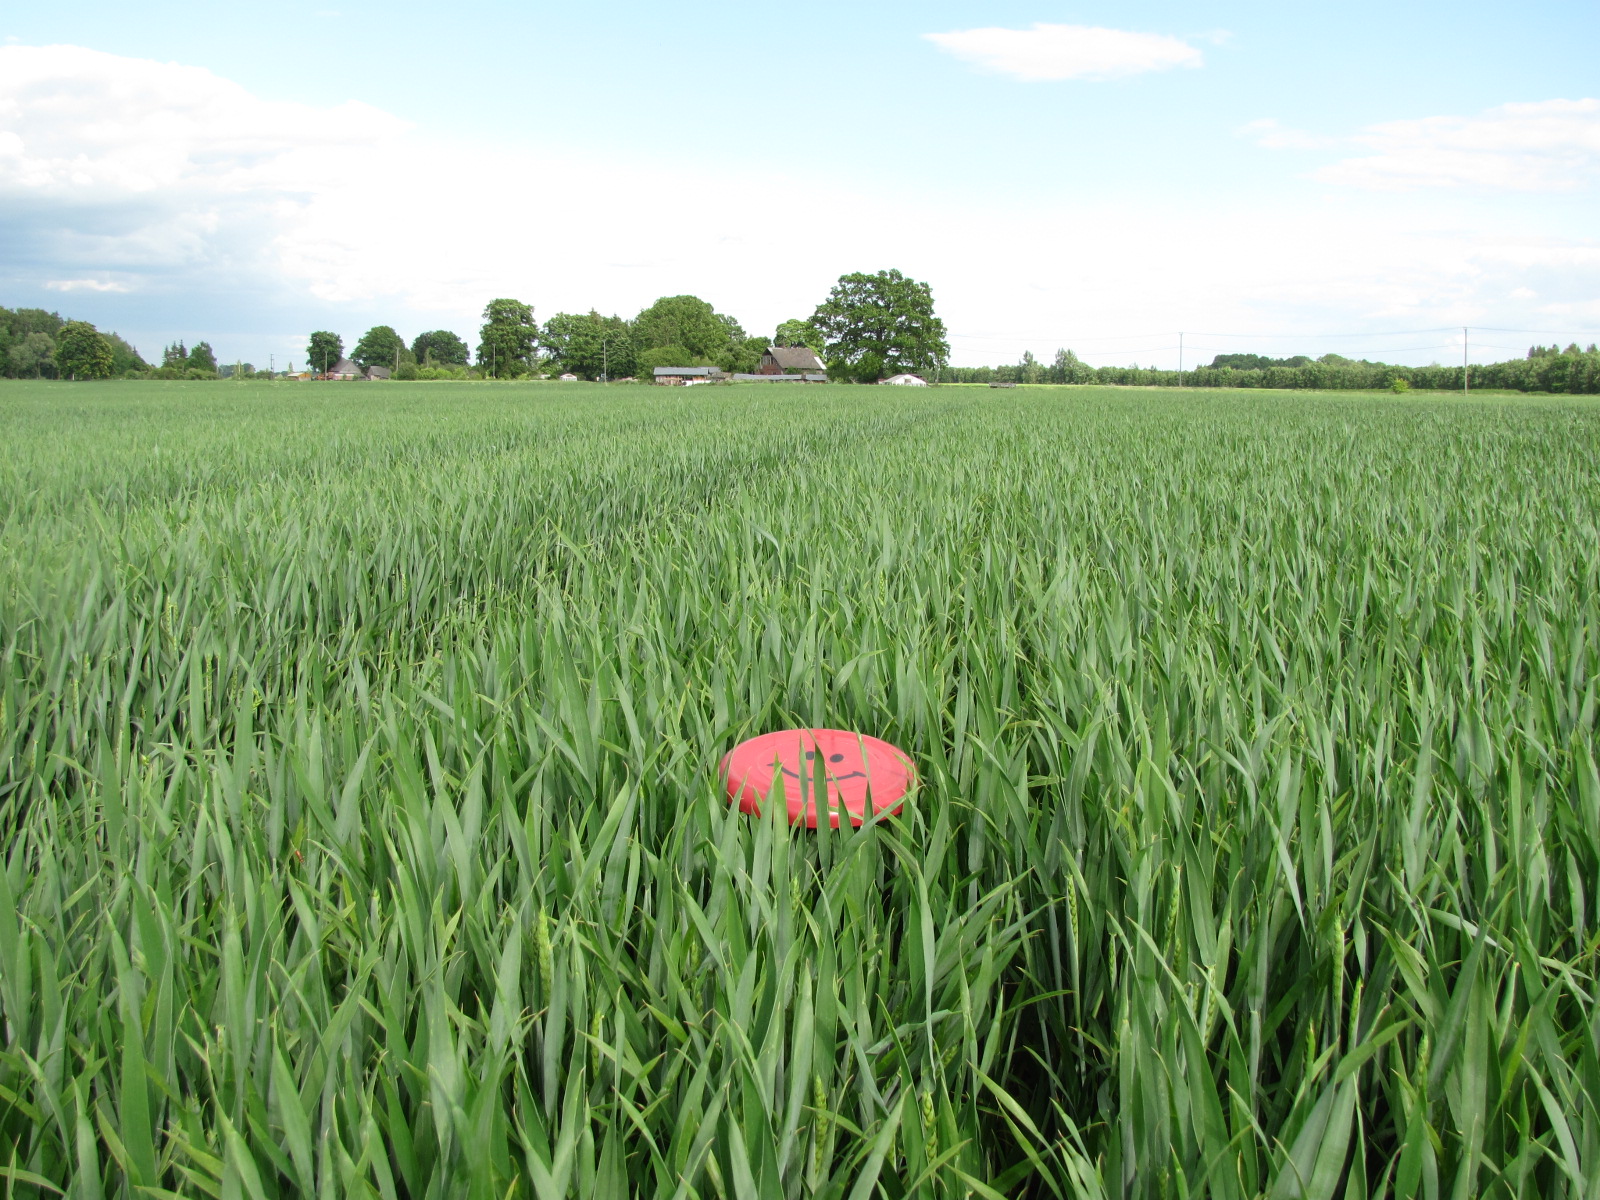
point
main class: Cropland
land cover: Common wheat
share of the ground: > 75 %
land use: Agriculture (excluding fallow land and kitchen gardens)
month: June
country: LV
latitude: 56.3632
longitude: 24.1886
